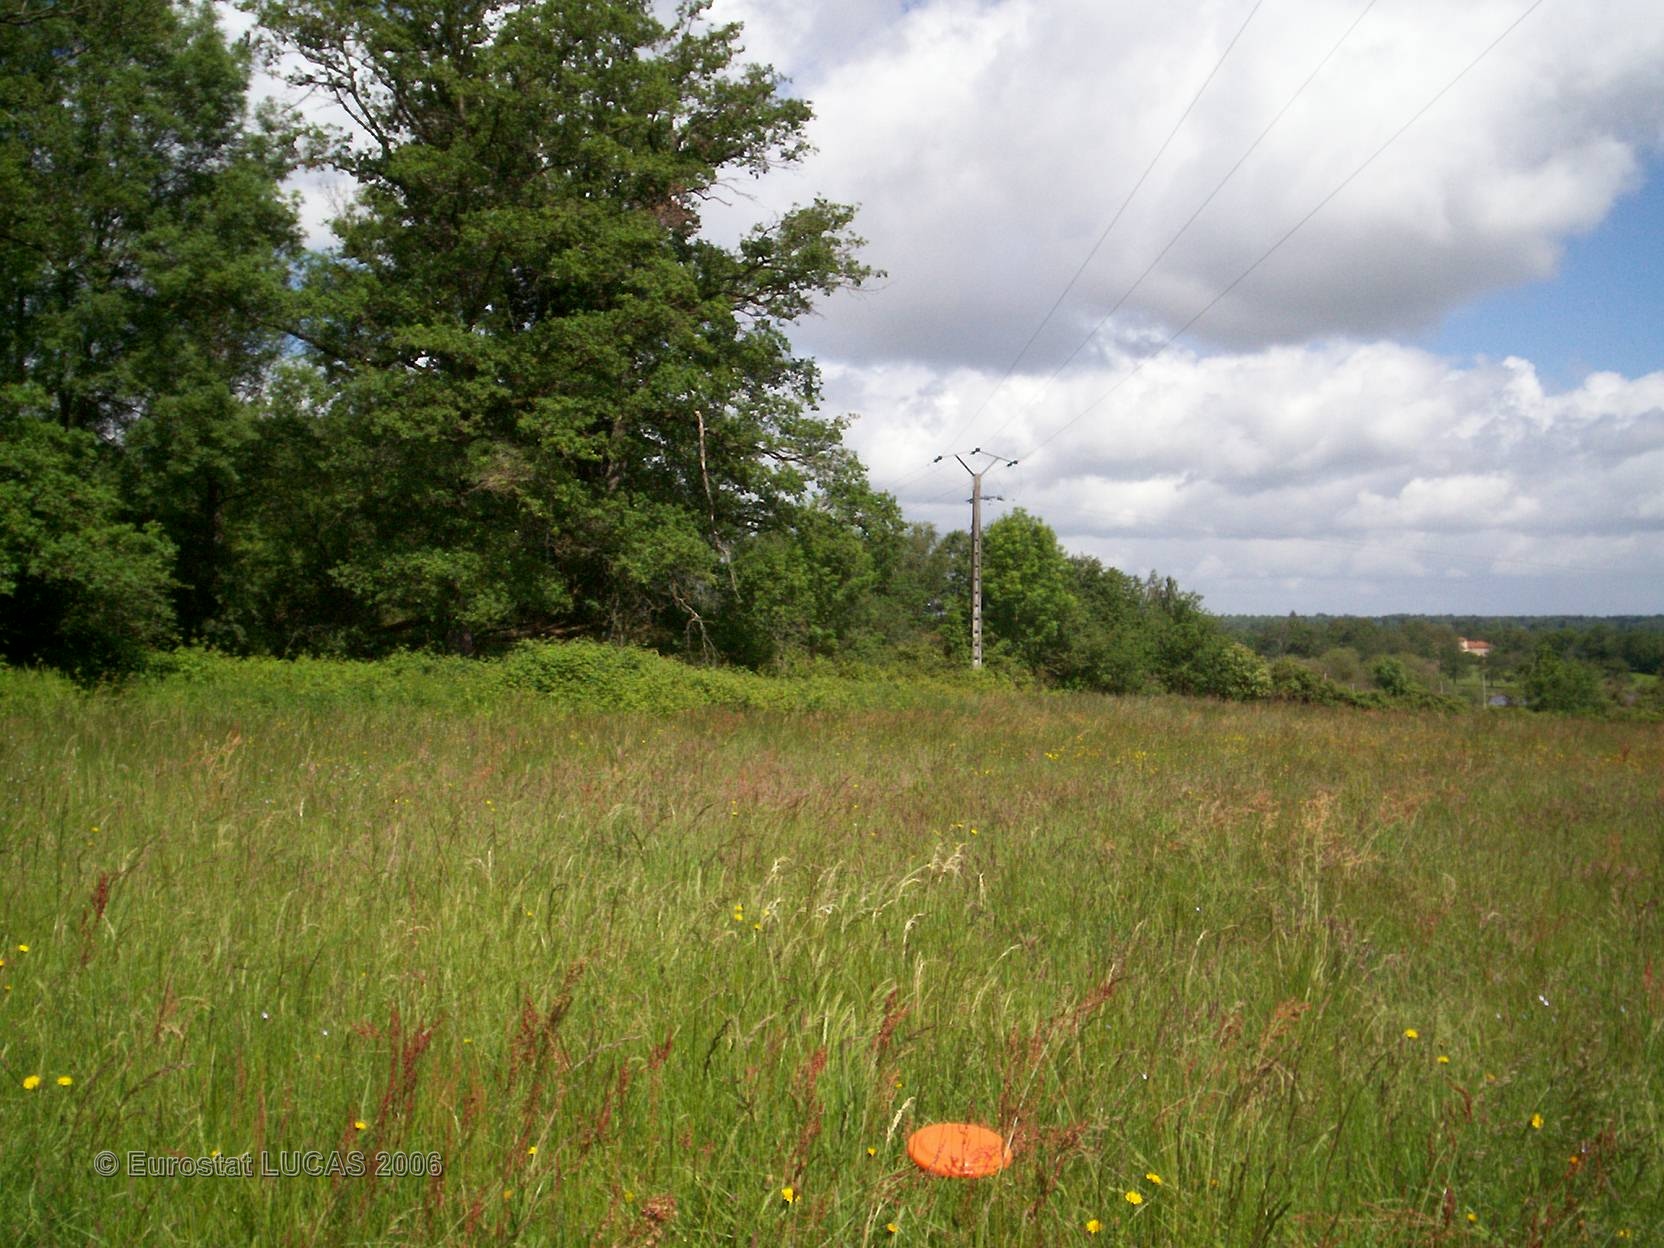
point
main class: Grassland
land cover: Grassland without tree/shrub cover
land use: Agriculture (excluding fallow land and kitchen gardens)
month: May
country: FR
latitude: 46.0310
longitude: 0.6448
